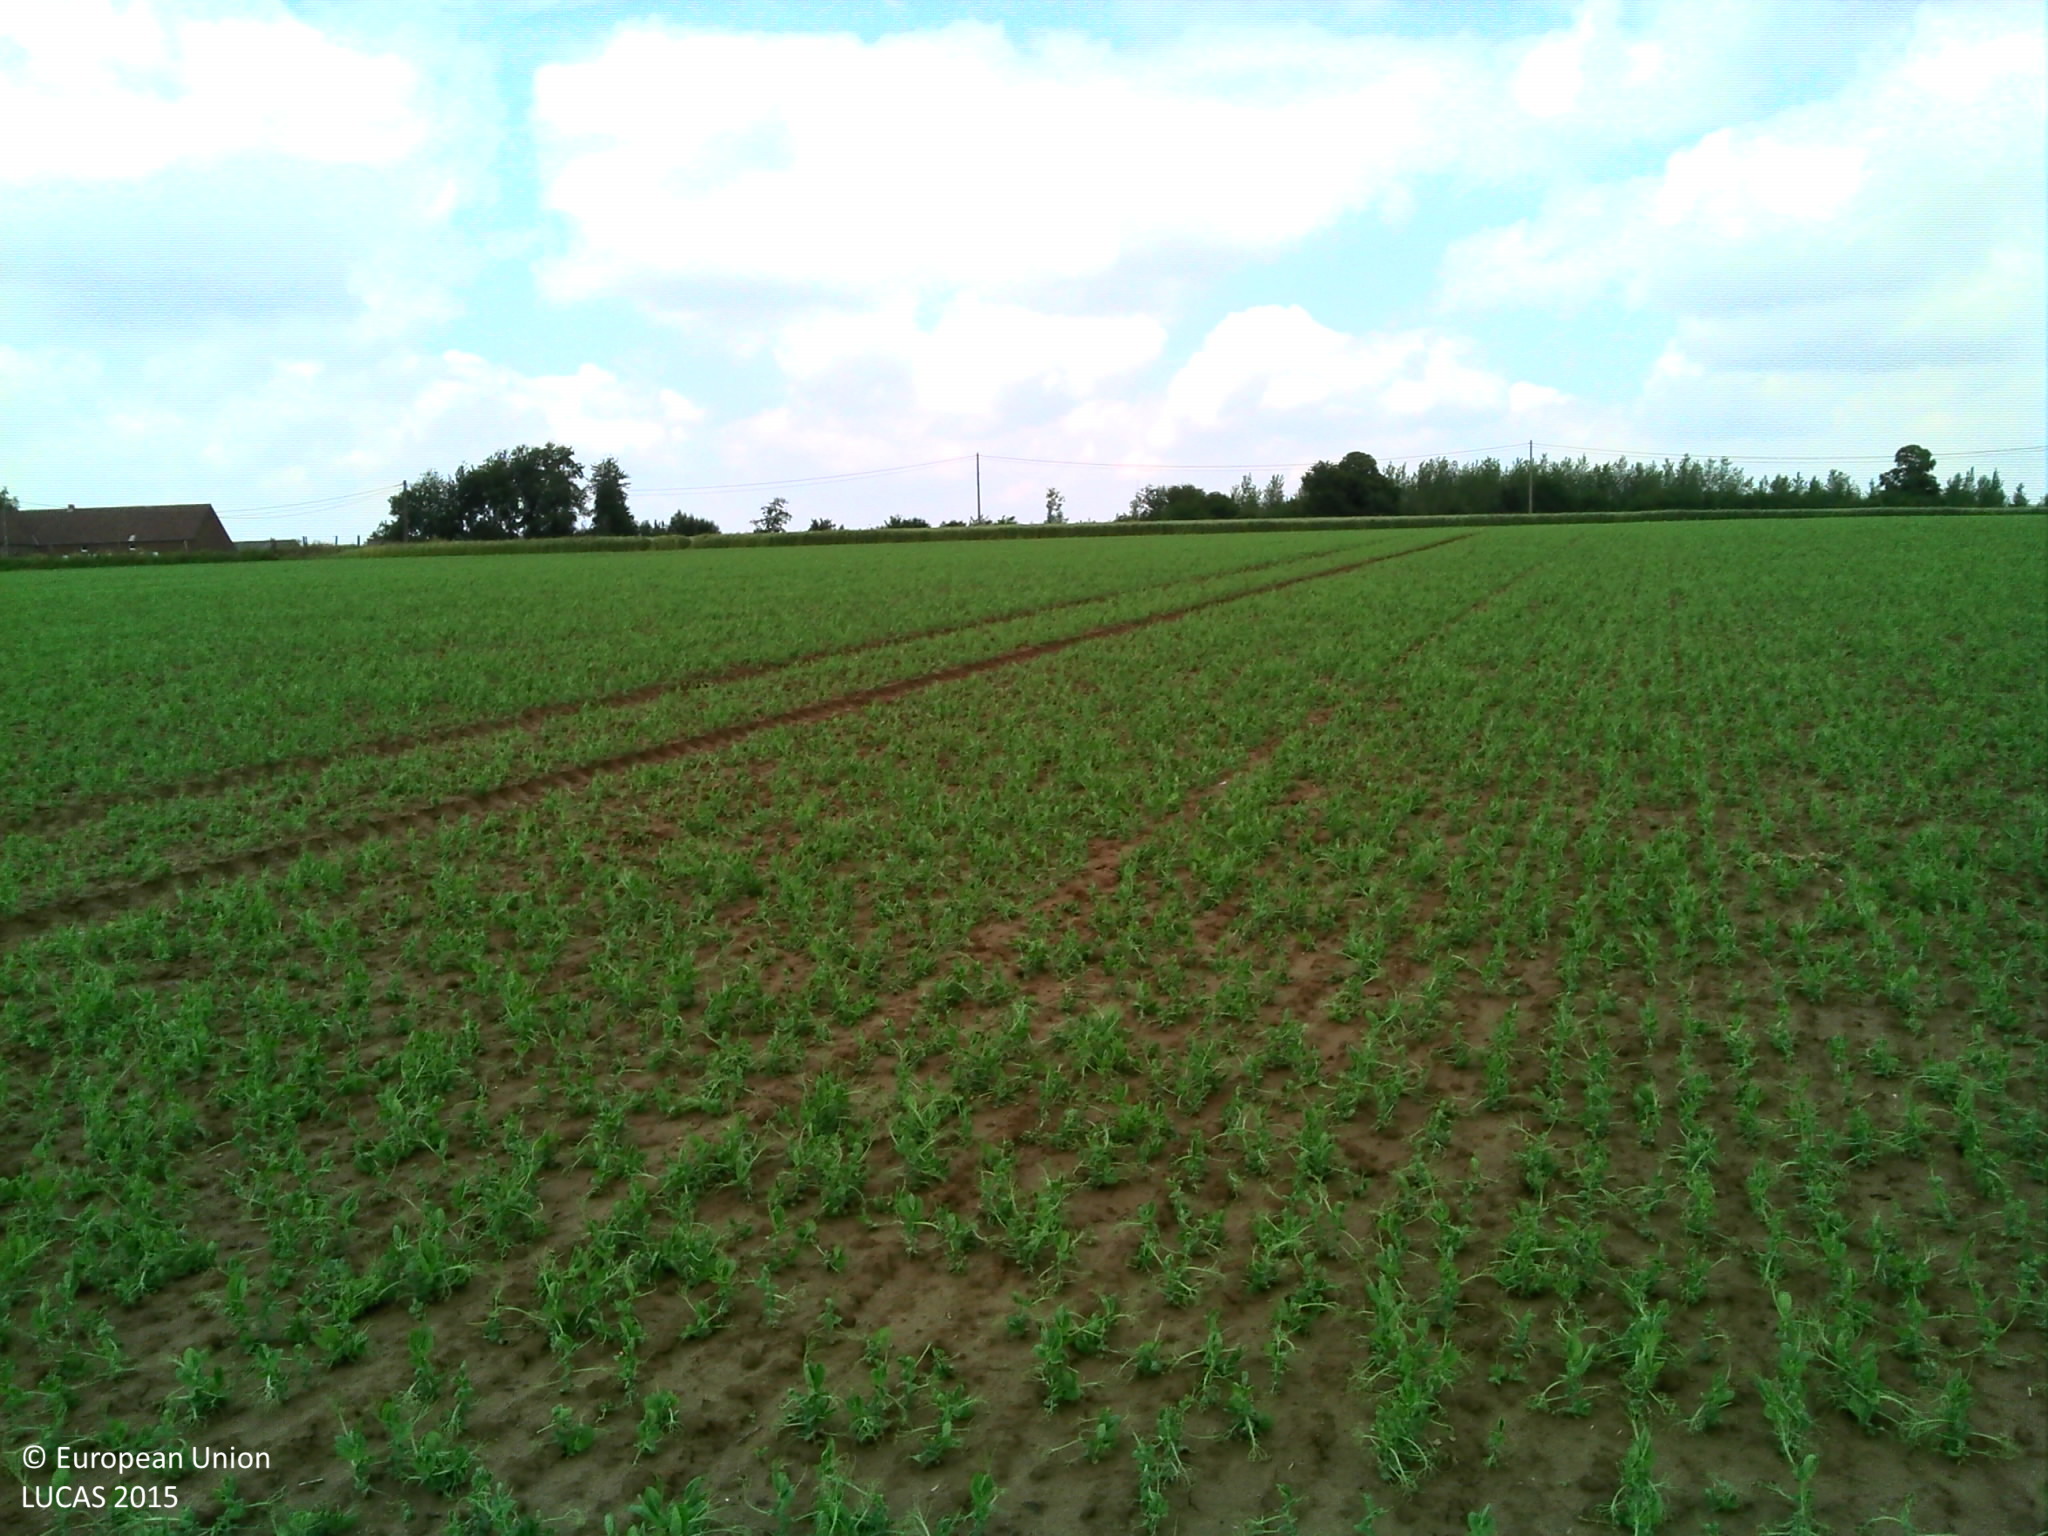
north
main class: Cropland
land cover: Dry pulses
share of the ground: 25 - 50 %
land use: Agriculture (excluding fallow land and kitchen gardens)
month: June
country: BE
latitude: 50.6295
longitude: 3.8156
